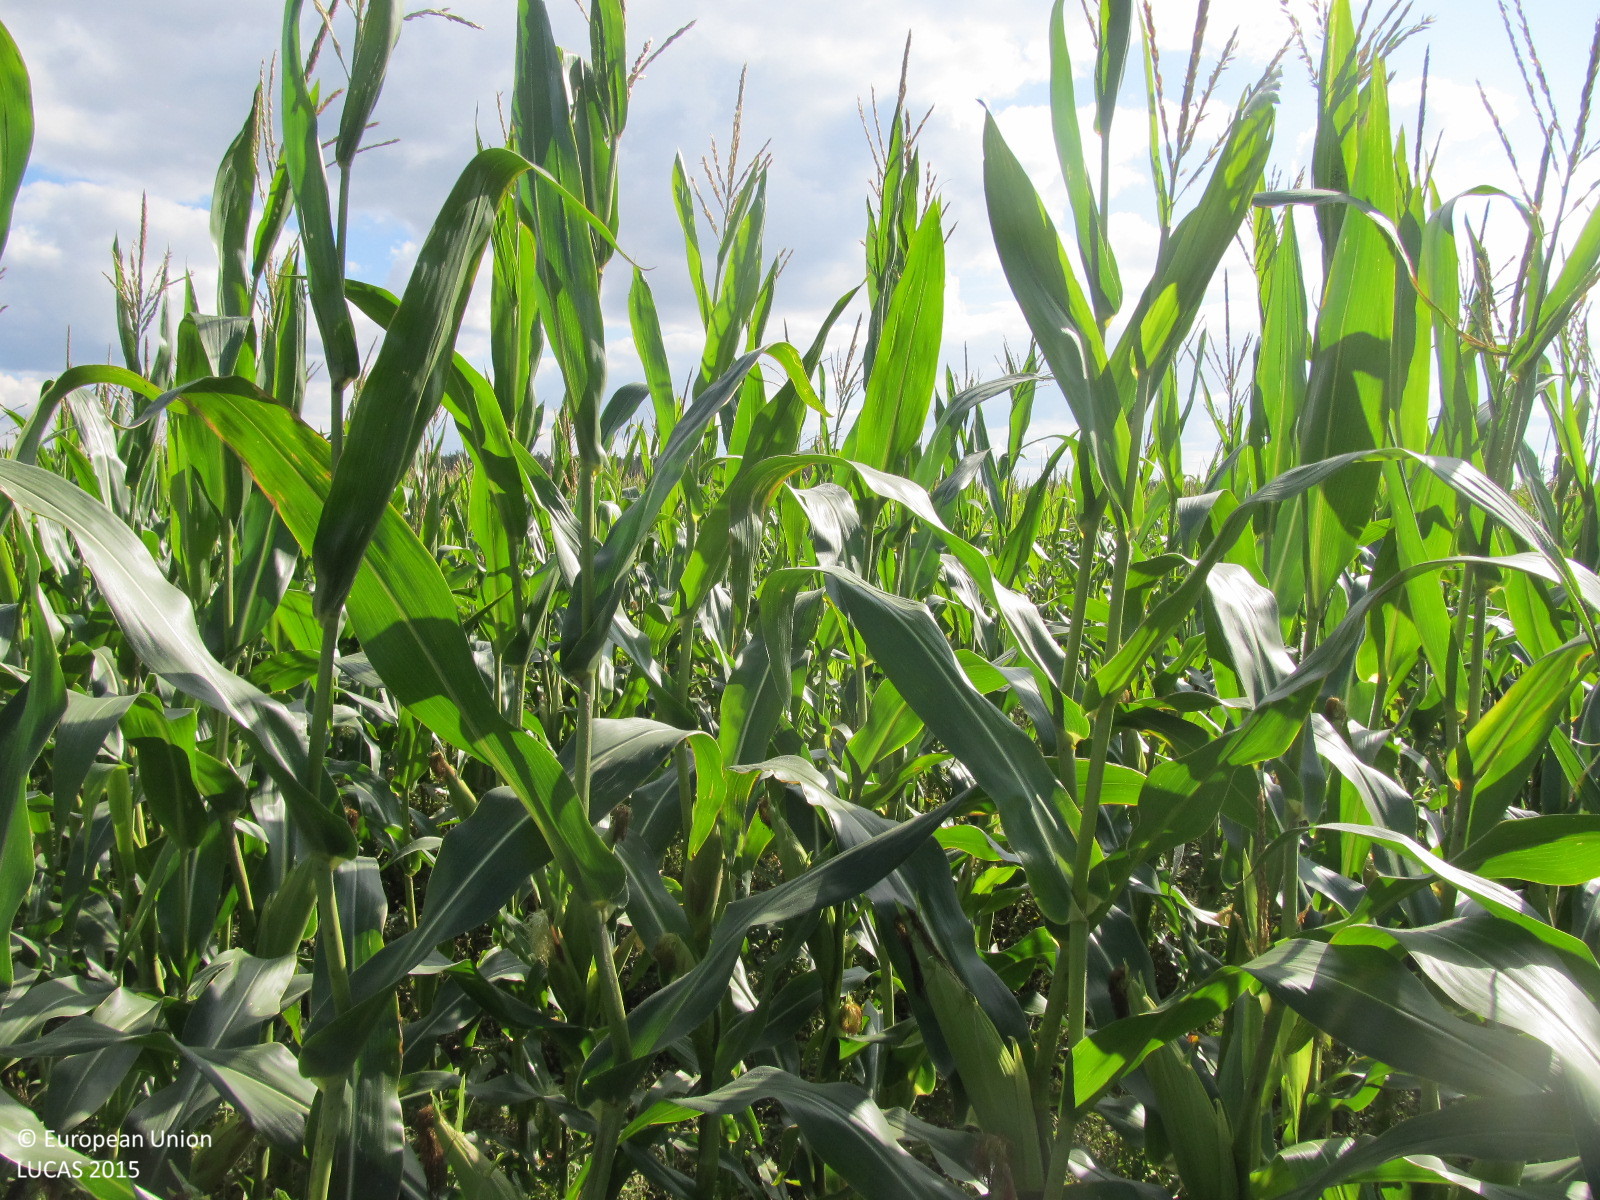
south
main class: Cropland
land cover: Maize
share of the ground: > 75 %
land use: Agriculture (excluding fallow land and kitchen gardens)
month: September
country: LT
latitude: 56.2898
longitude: 22.8104
